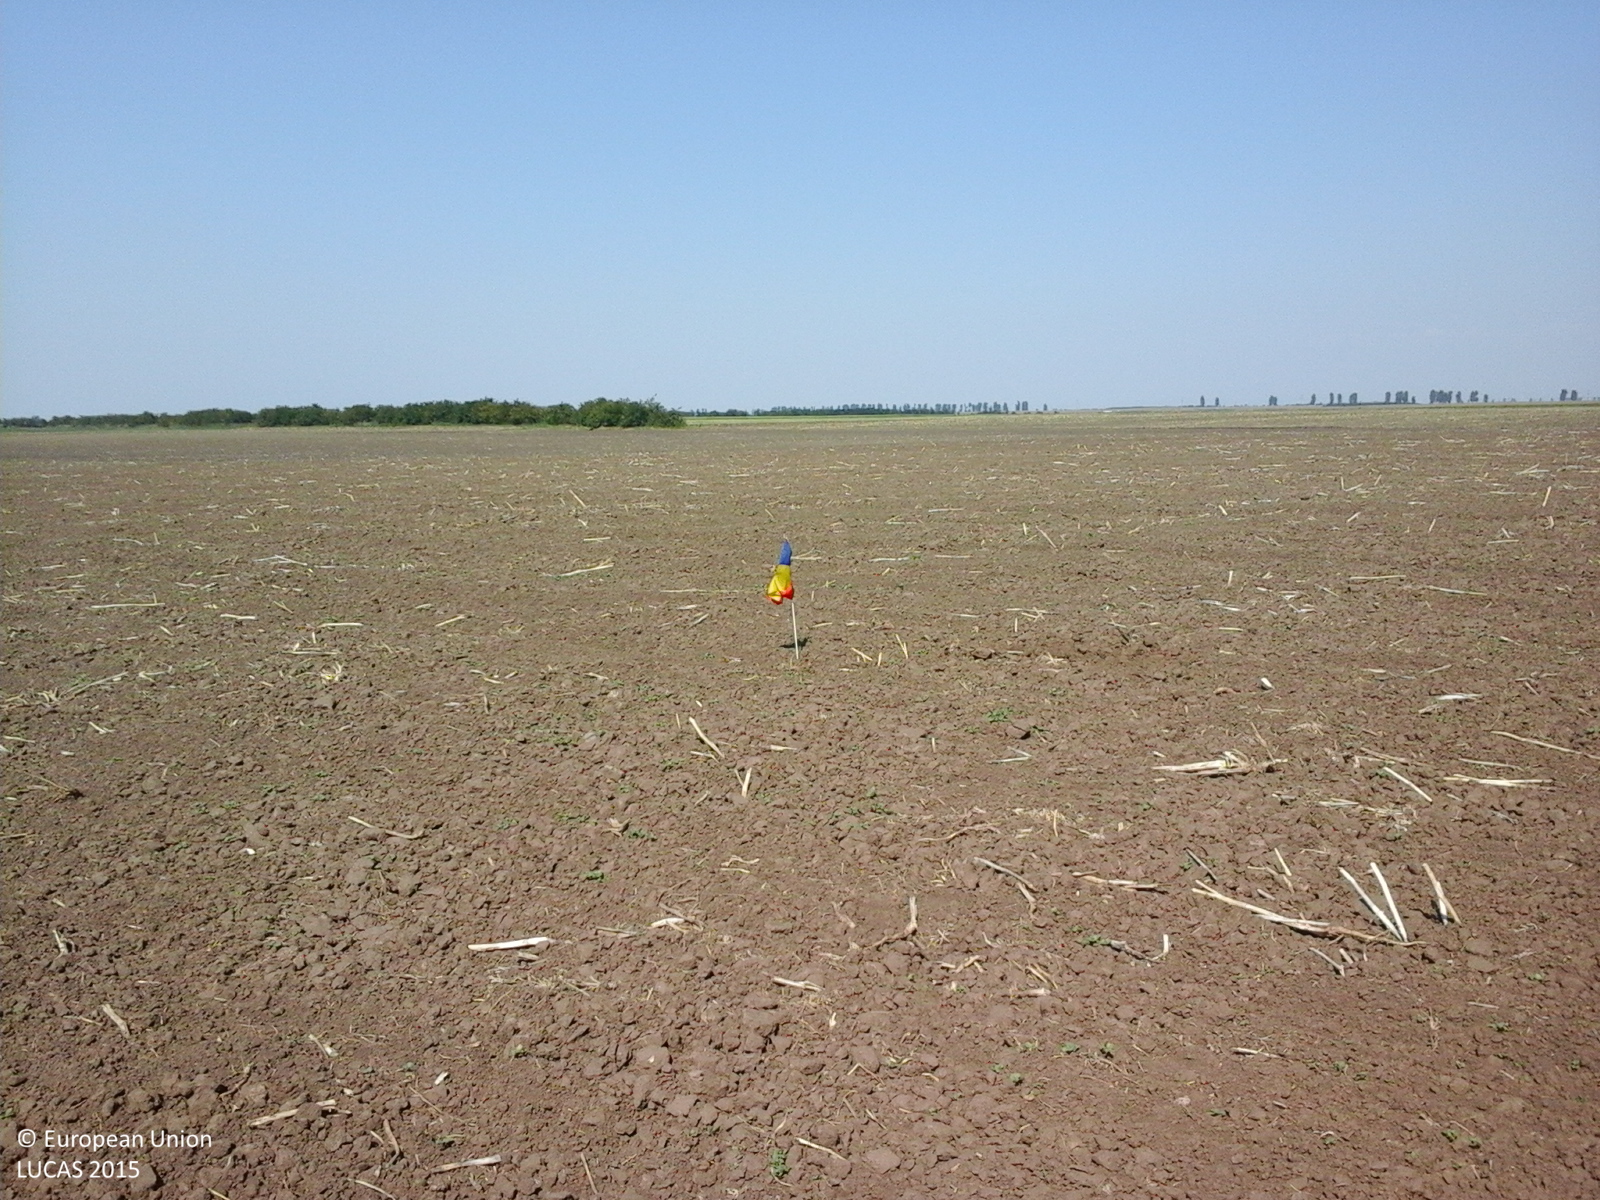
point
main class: Cropland
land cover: Common wheat
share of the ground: < 10 %
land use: Agriculture (excluding fallow land and kitchen gardens)
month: July
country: RO
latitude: 44.9036
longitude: 27.2240
